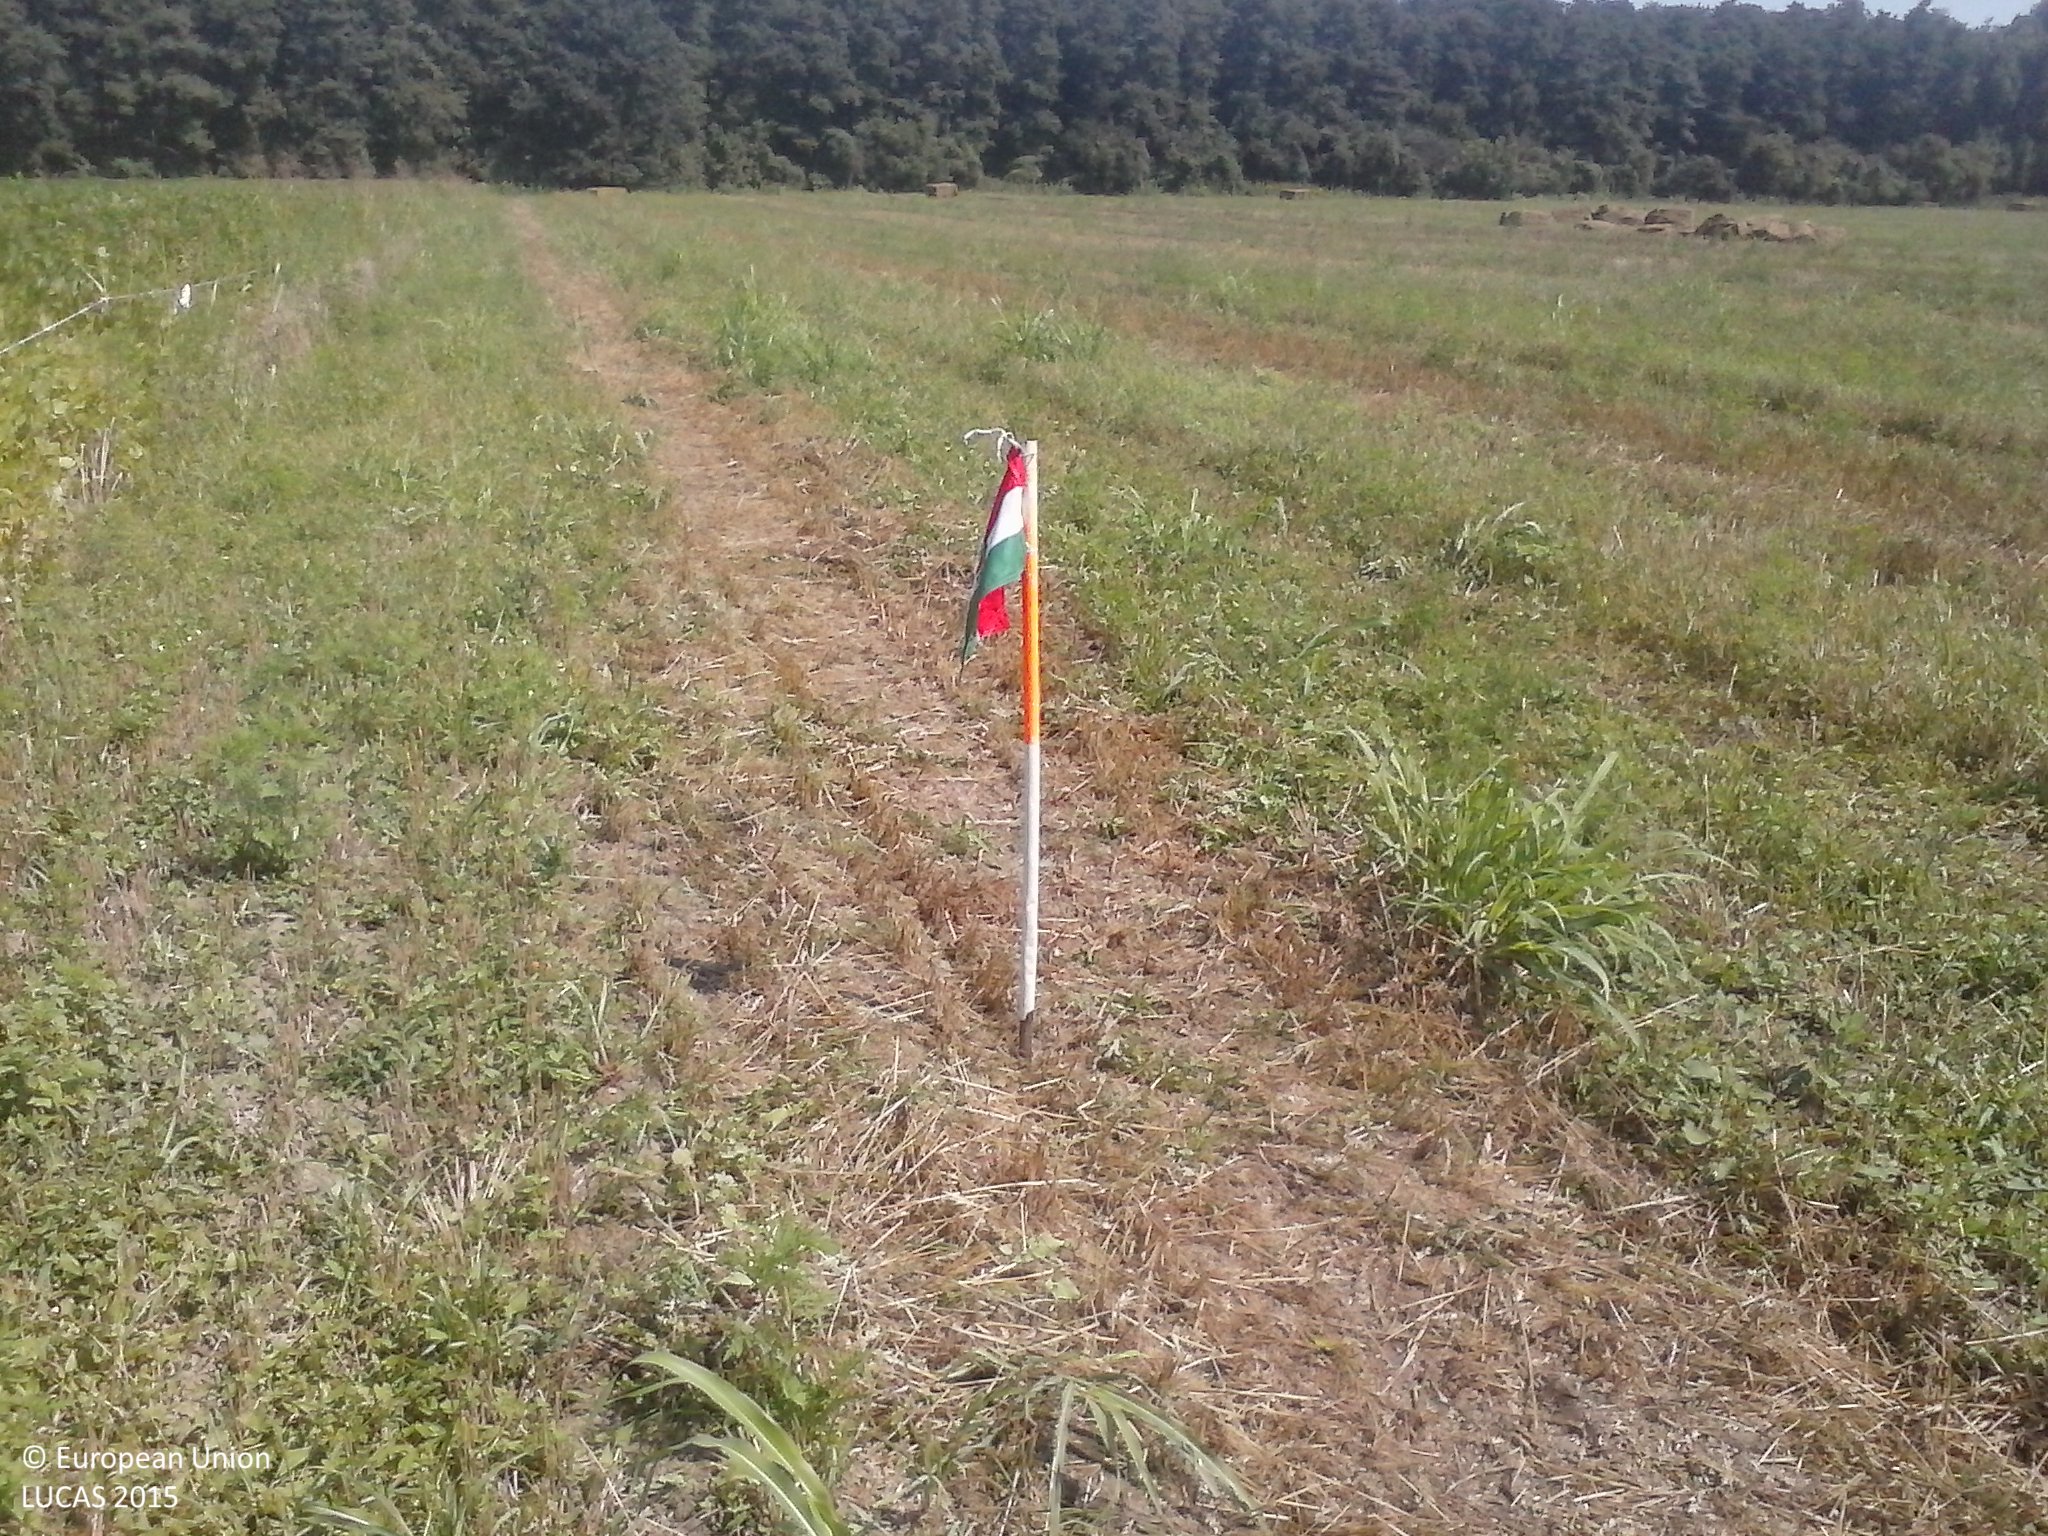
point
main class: Cropland
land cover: Common wheat
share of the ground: 10 - 25 %
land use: Agriculture (excluding fallow land and kitchen gardens)
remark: Harvested field
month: August
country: HU
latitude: 45.8239
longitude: 17.8948
